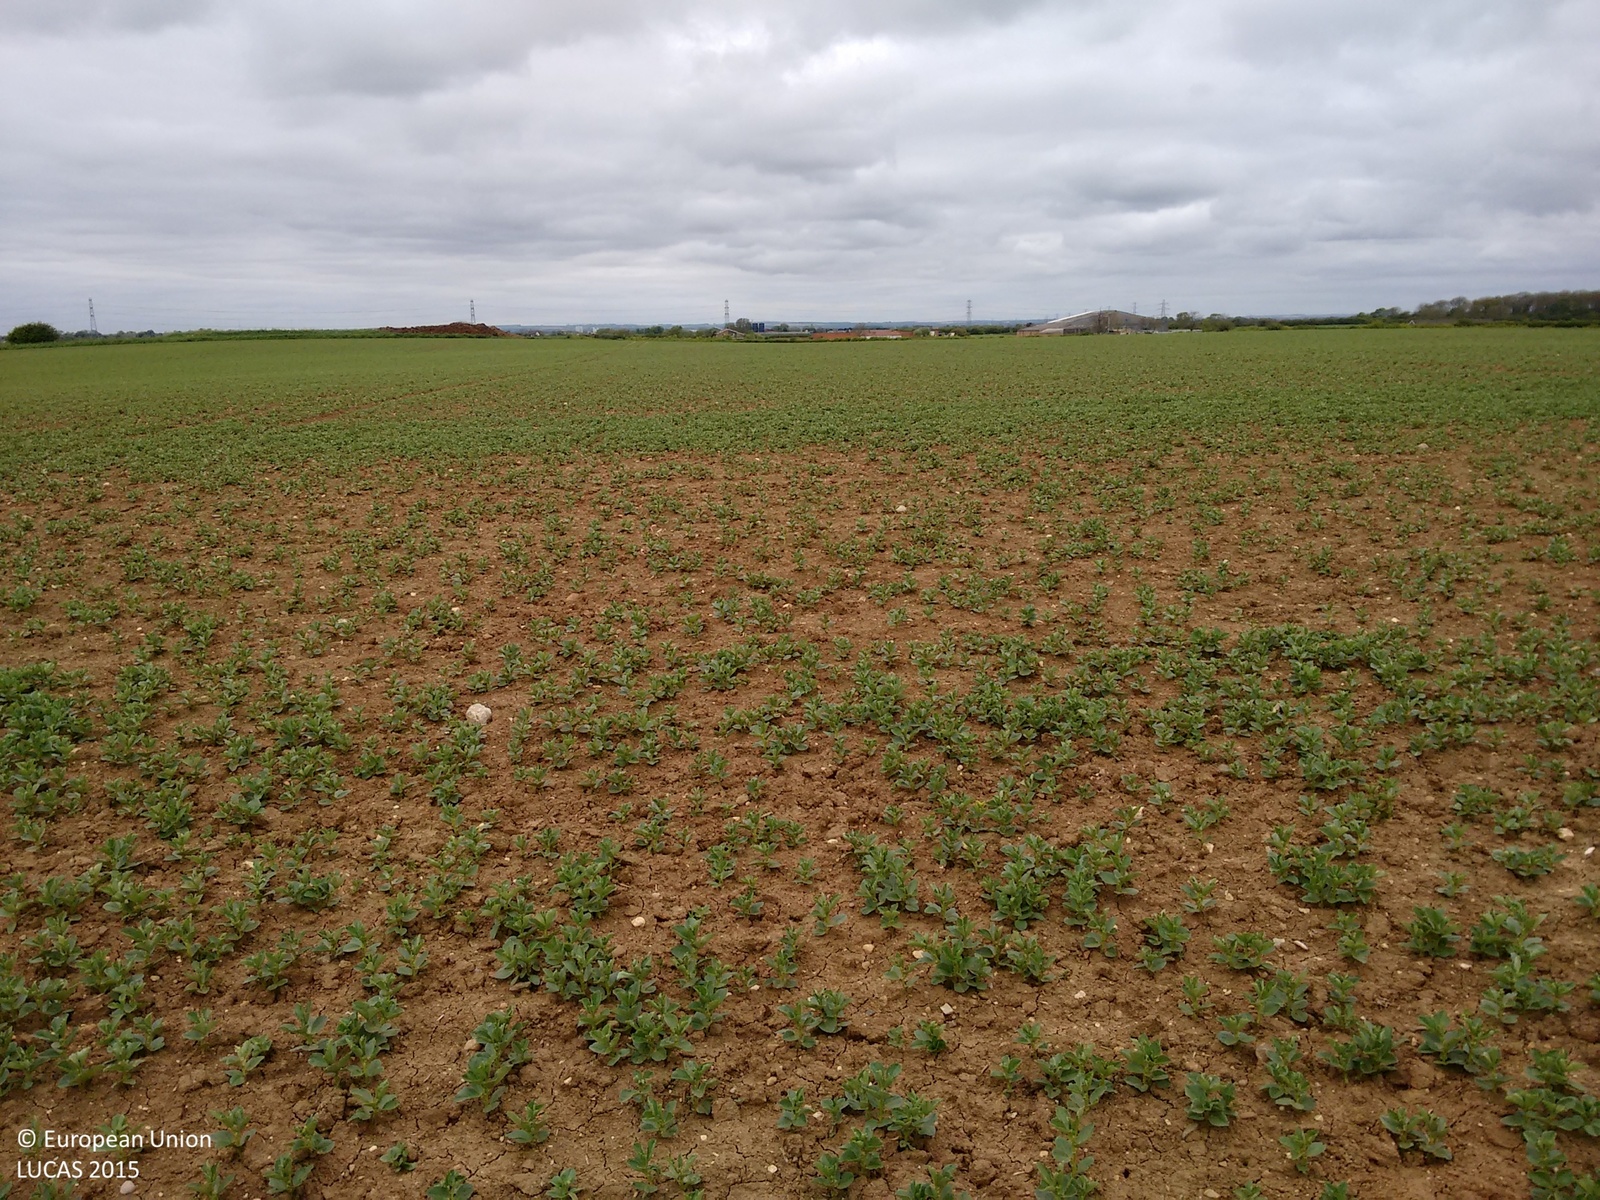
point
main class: Cropland
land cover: Dry pulses
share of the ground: 25 - 50 %
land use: Agriculture (excluding fallow land and kitchen gardens)
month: May
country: GB
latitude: 53.8021
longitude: -0.2219
